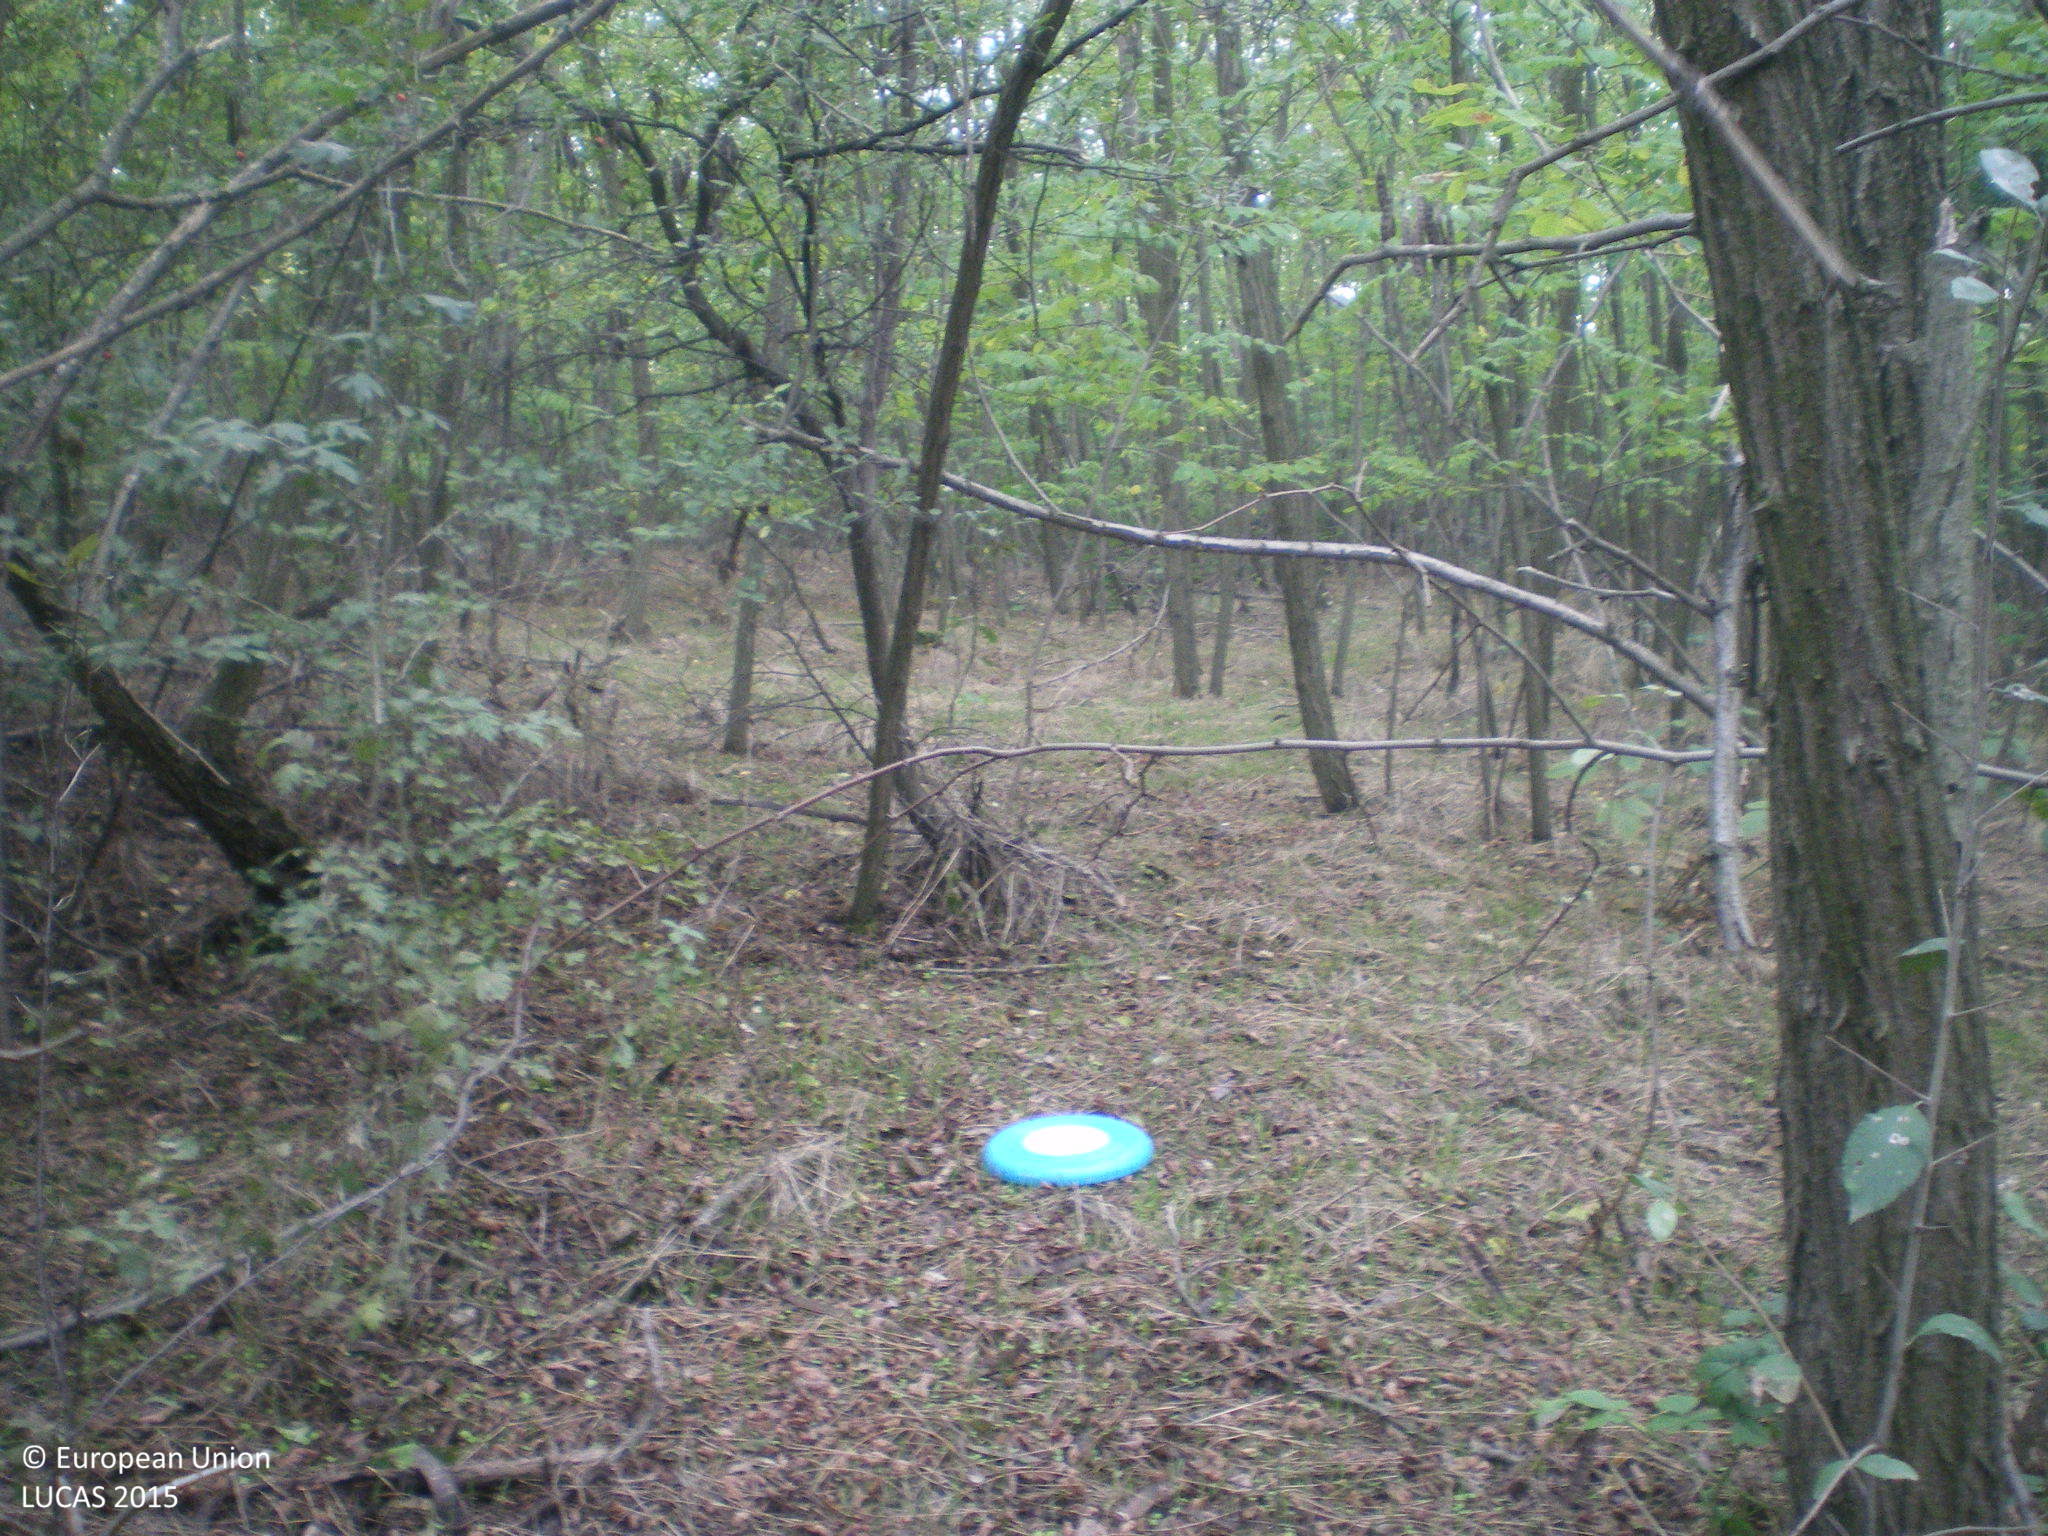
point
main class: Woodland
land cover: Broadleaved woodland
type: mesophytic deciduous forest
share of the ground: > 75 %
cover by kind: broadleaved forest trees 95 %, unconsolidated bare surface 5 %
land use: Forestry
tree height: > 5 m
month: October
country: BG
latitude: 42.1713
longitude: 25.9456
